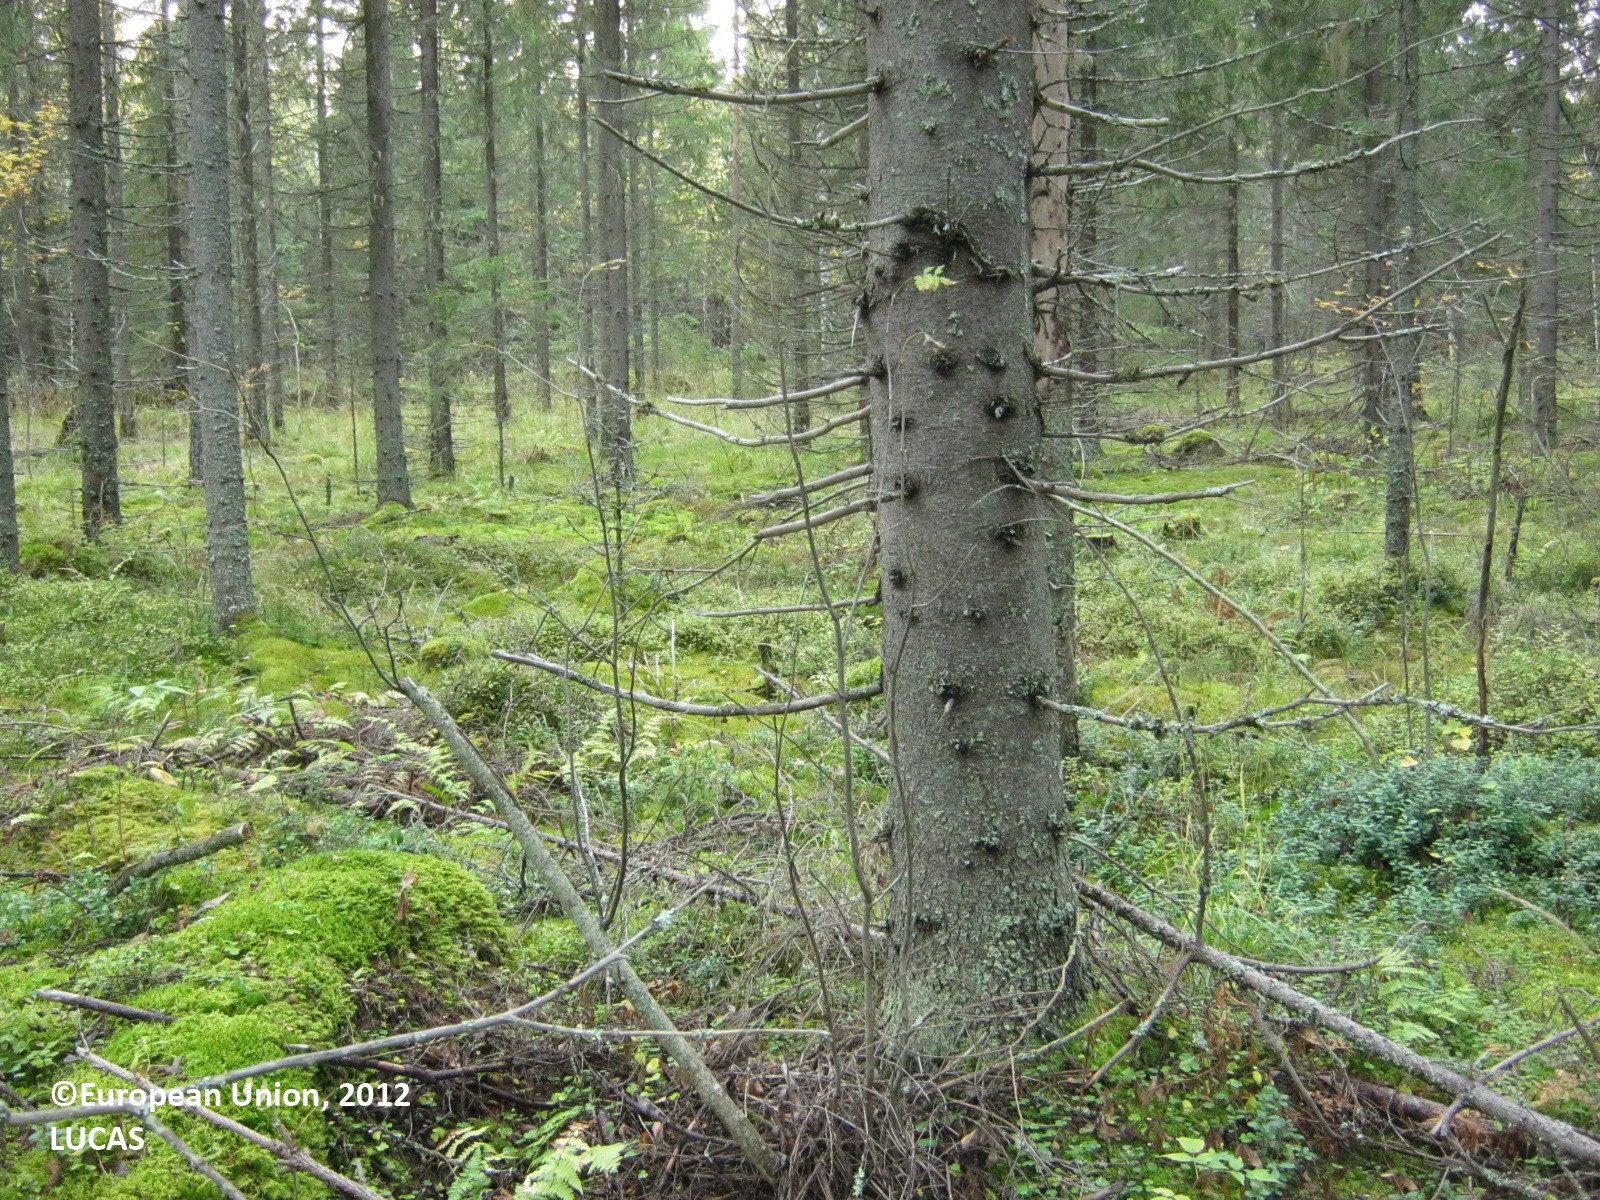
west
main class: Woodland
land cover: Spruce dominated coniferous woodland
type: boreal forest
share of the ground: 50 - 75 %
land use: Forestry
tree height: > 5 m
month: September
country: FI
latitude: 62.4050
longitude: 28.8905
